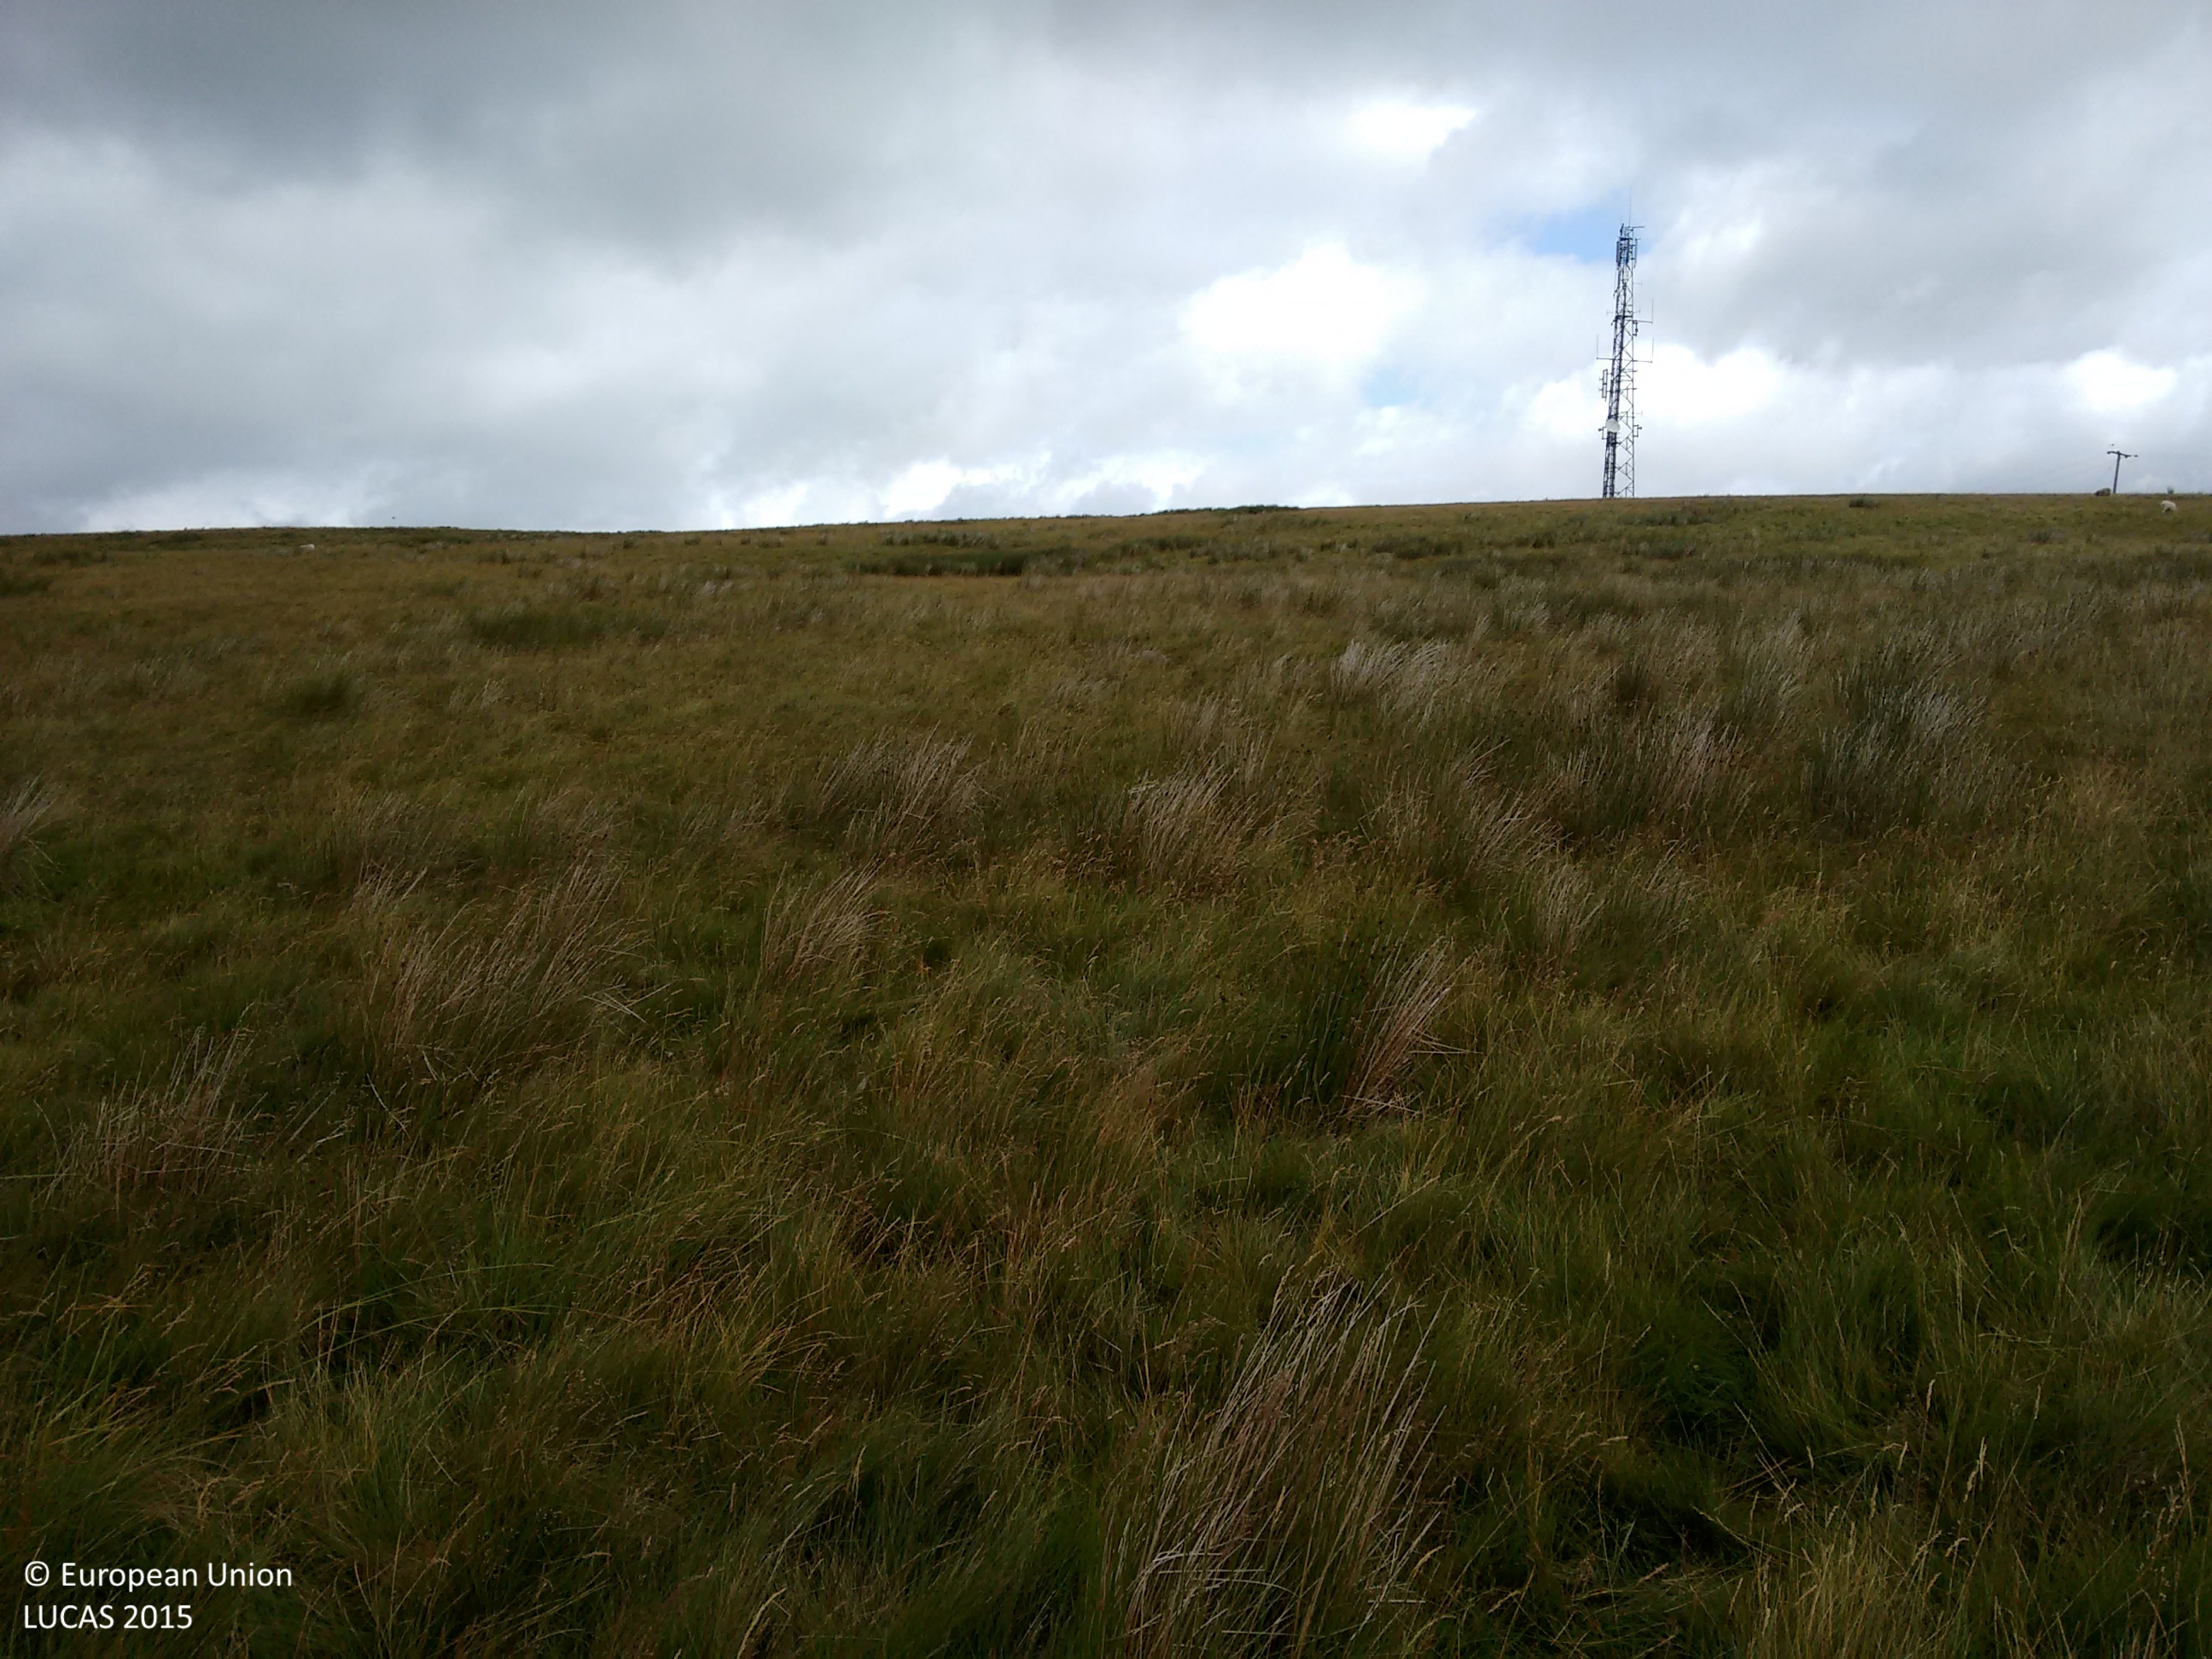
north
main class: Grassland
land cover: Grassland without tree/shrub cover
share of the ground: > 75 %
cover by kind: herbaceous plants 100 %
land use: Agriculture (excluding fallow land and kitchen gardens)
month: July
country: GB
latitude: 51.7385
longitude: -3.4203
